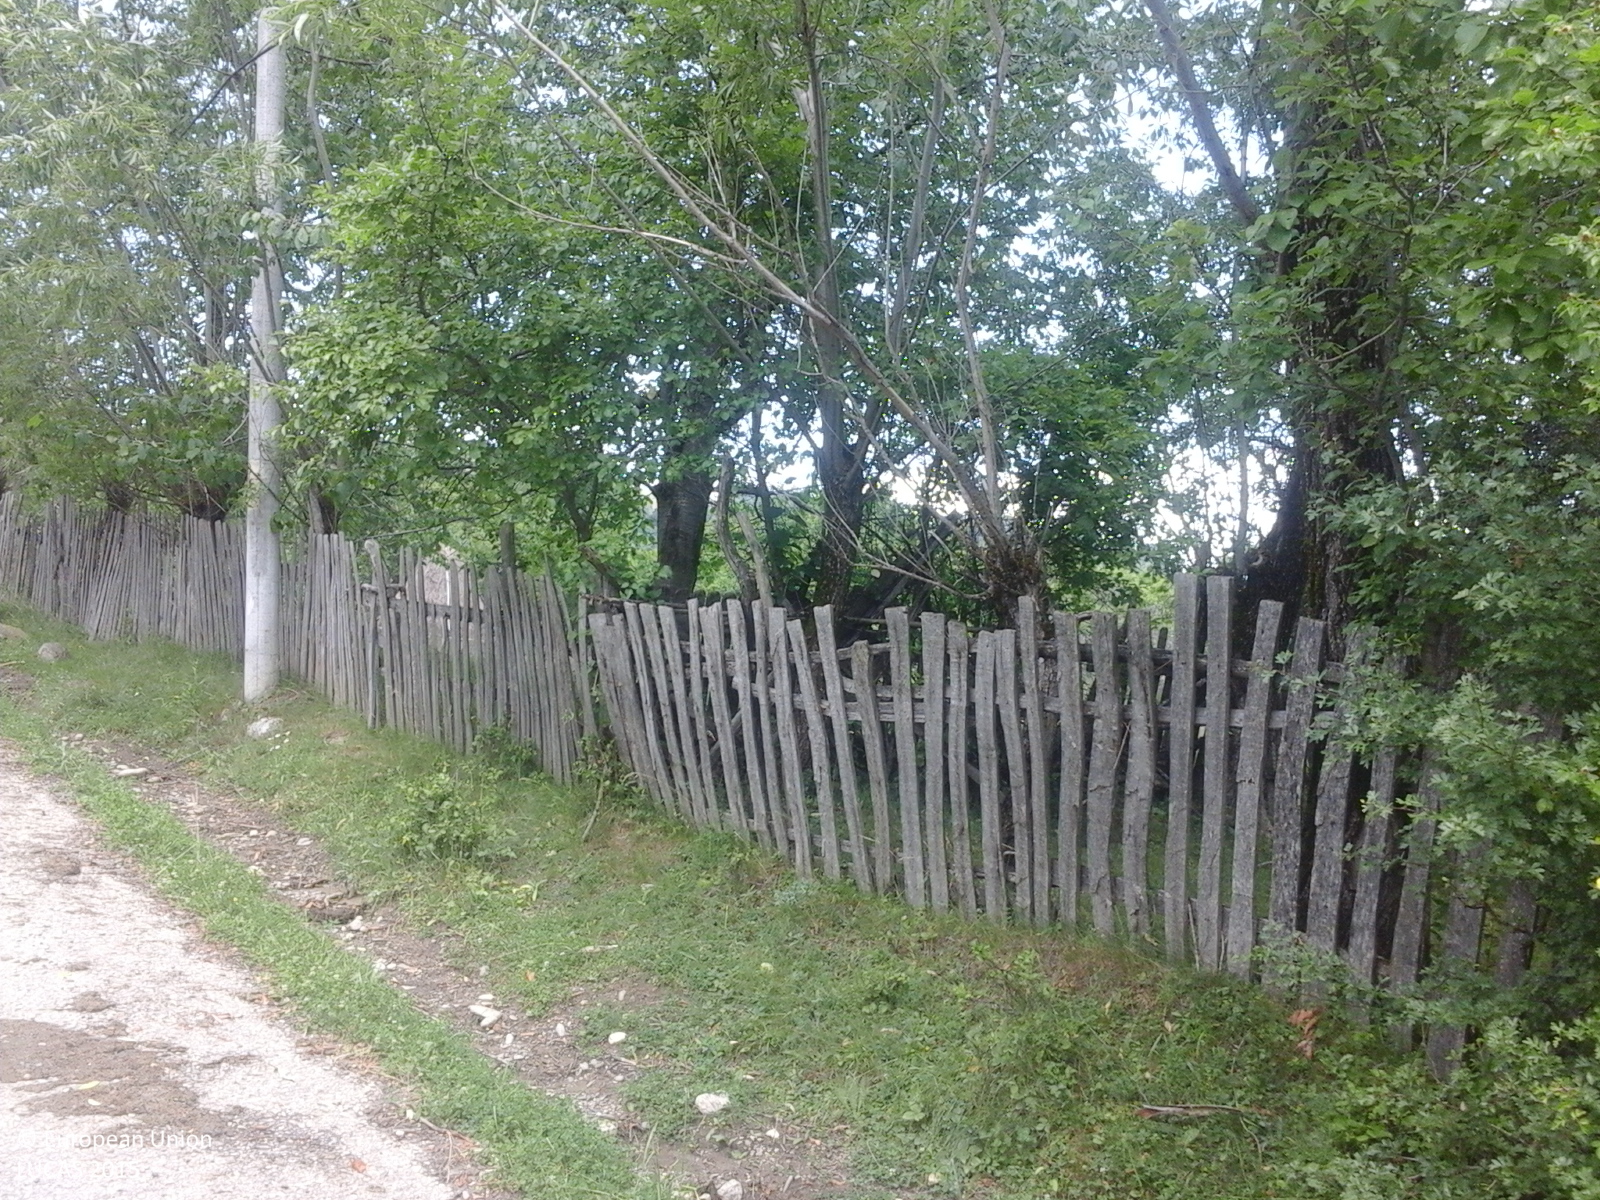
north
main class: Cropland
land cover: Other fruit trees and berries
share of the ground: 50 - 75 %
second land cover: Grassland without tree/shrub cover
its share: 50 - 75 %
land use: Agriculture (excluding fallow land and kitchen gardens)
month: July
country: RO
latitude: 45.3369
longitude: 24.7714
